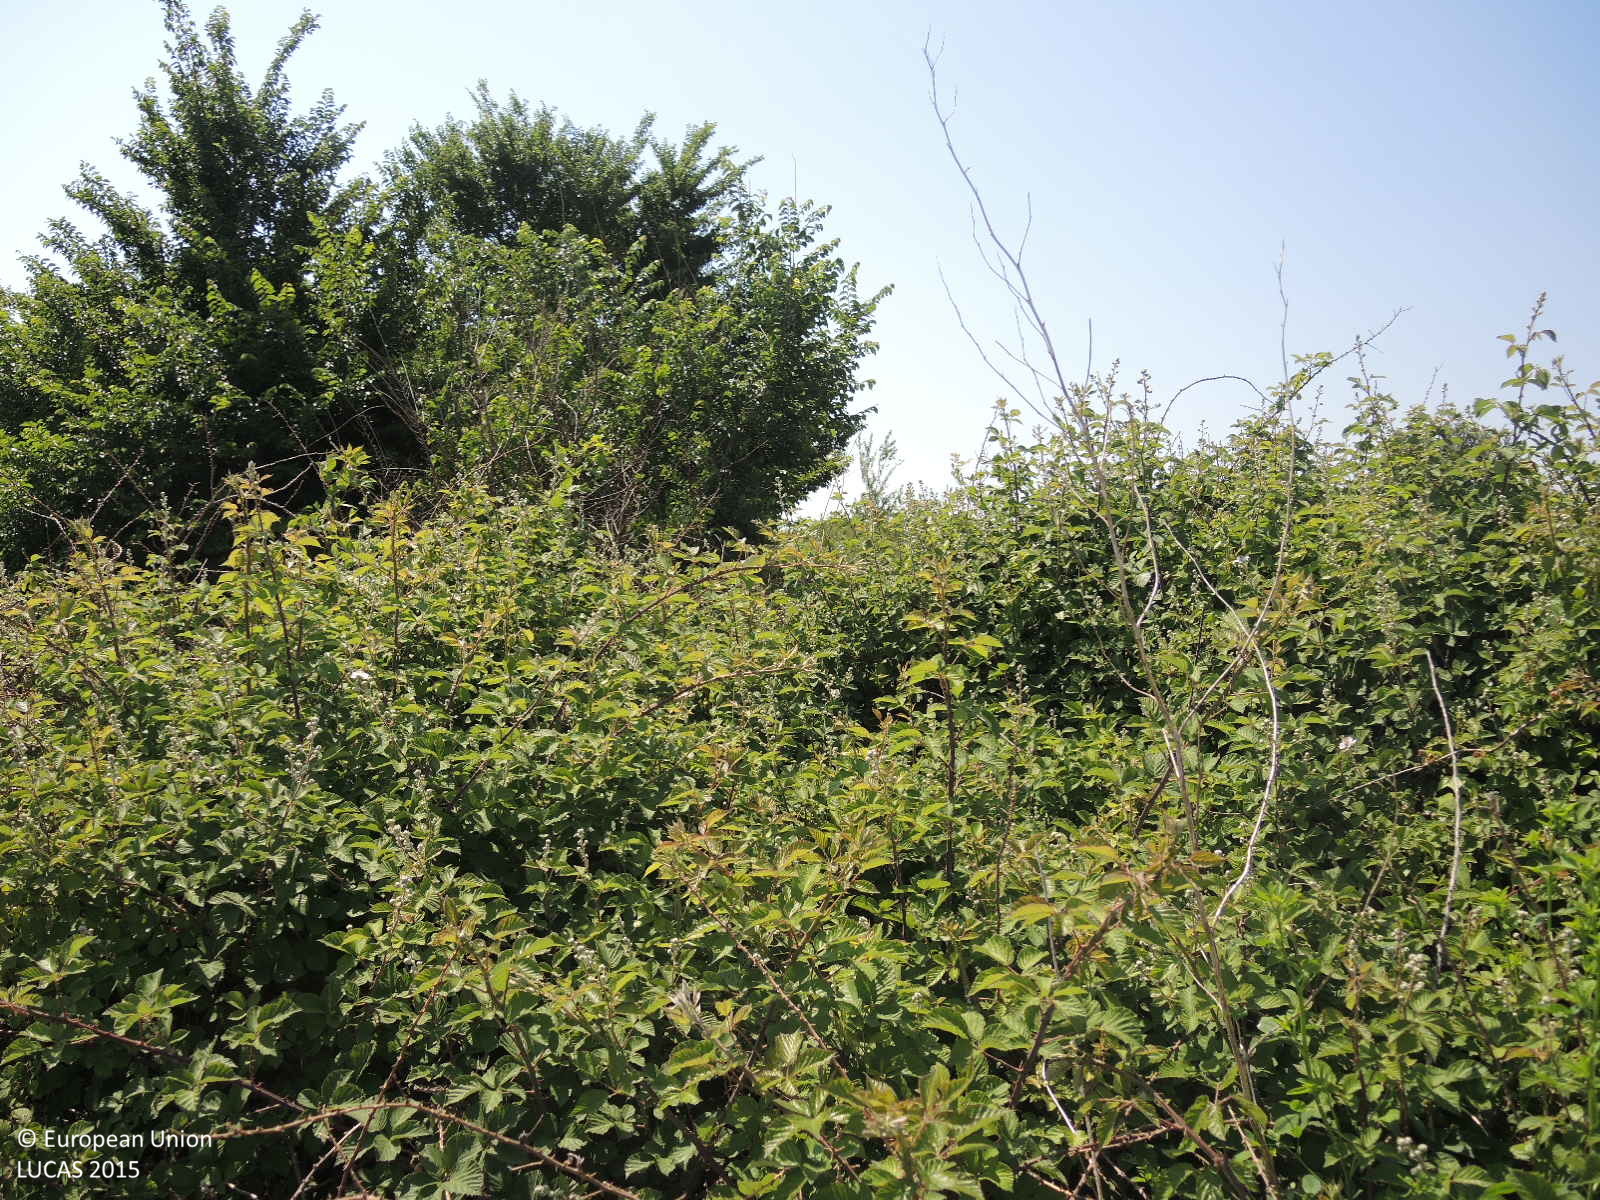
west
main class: Shrubland
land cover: Shrubland without tree cover
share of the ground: 50 - 75 %
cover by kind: shrubs 70 %, herbaceous plants 20 %, unconsolidated bare surface 10 %
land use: Semi-natural and natural areas not in use
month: May
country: HR
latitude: 44.1155
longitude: 15.4774
